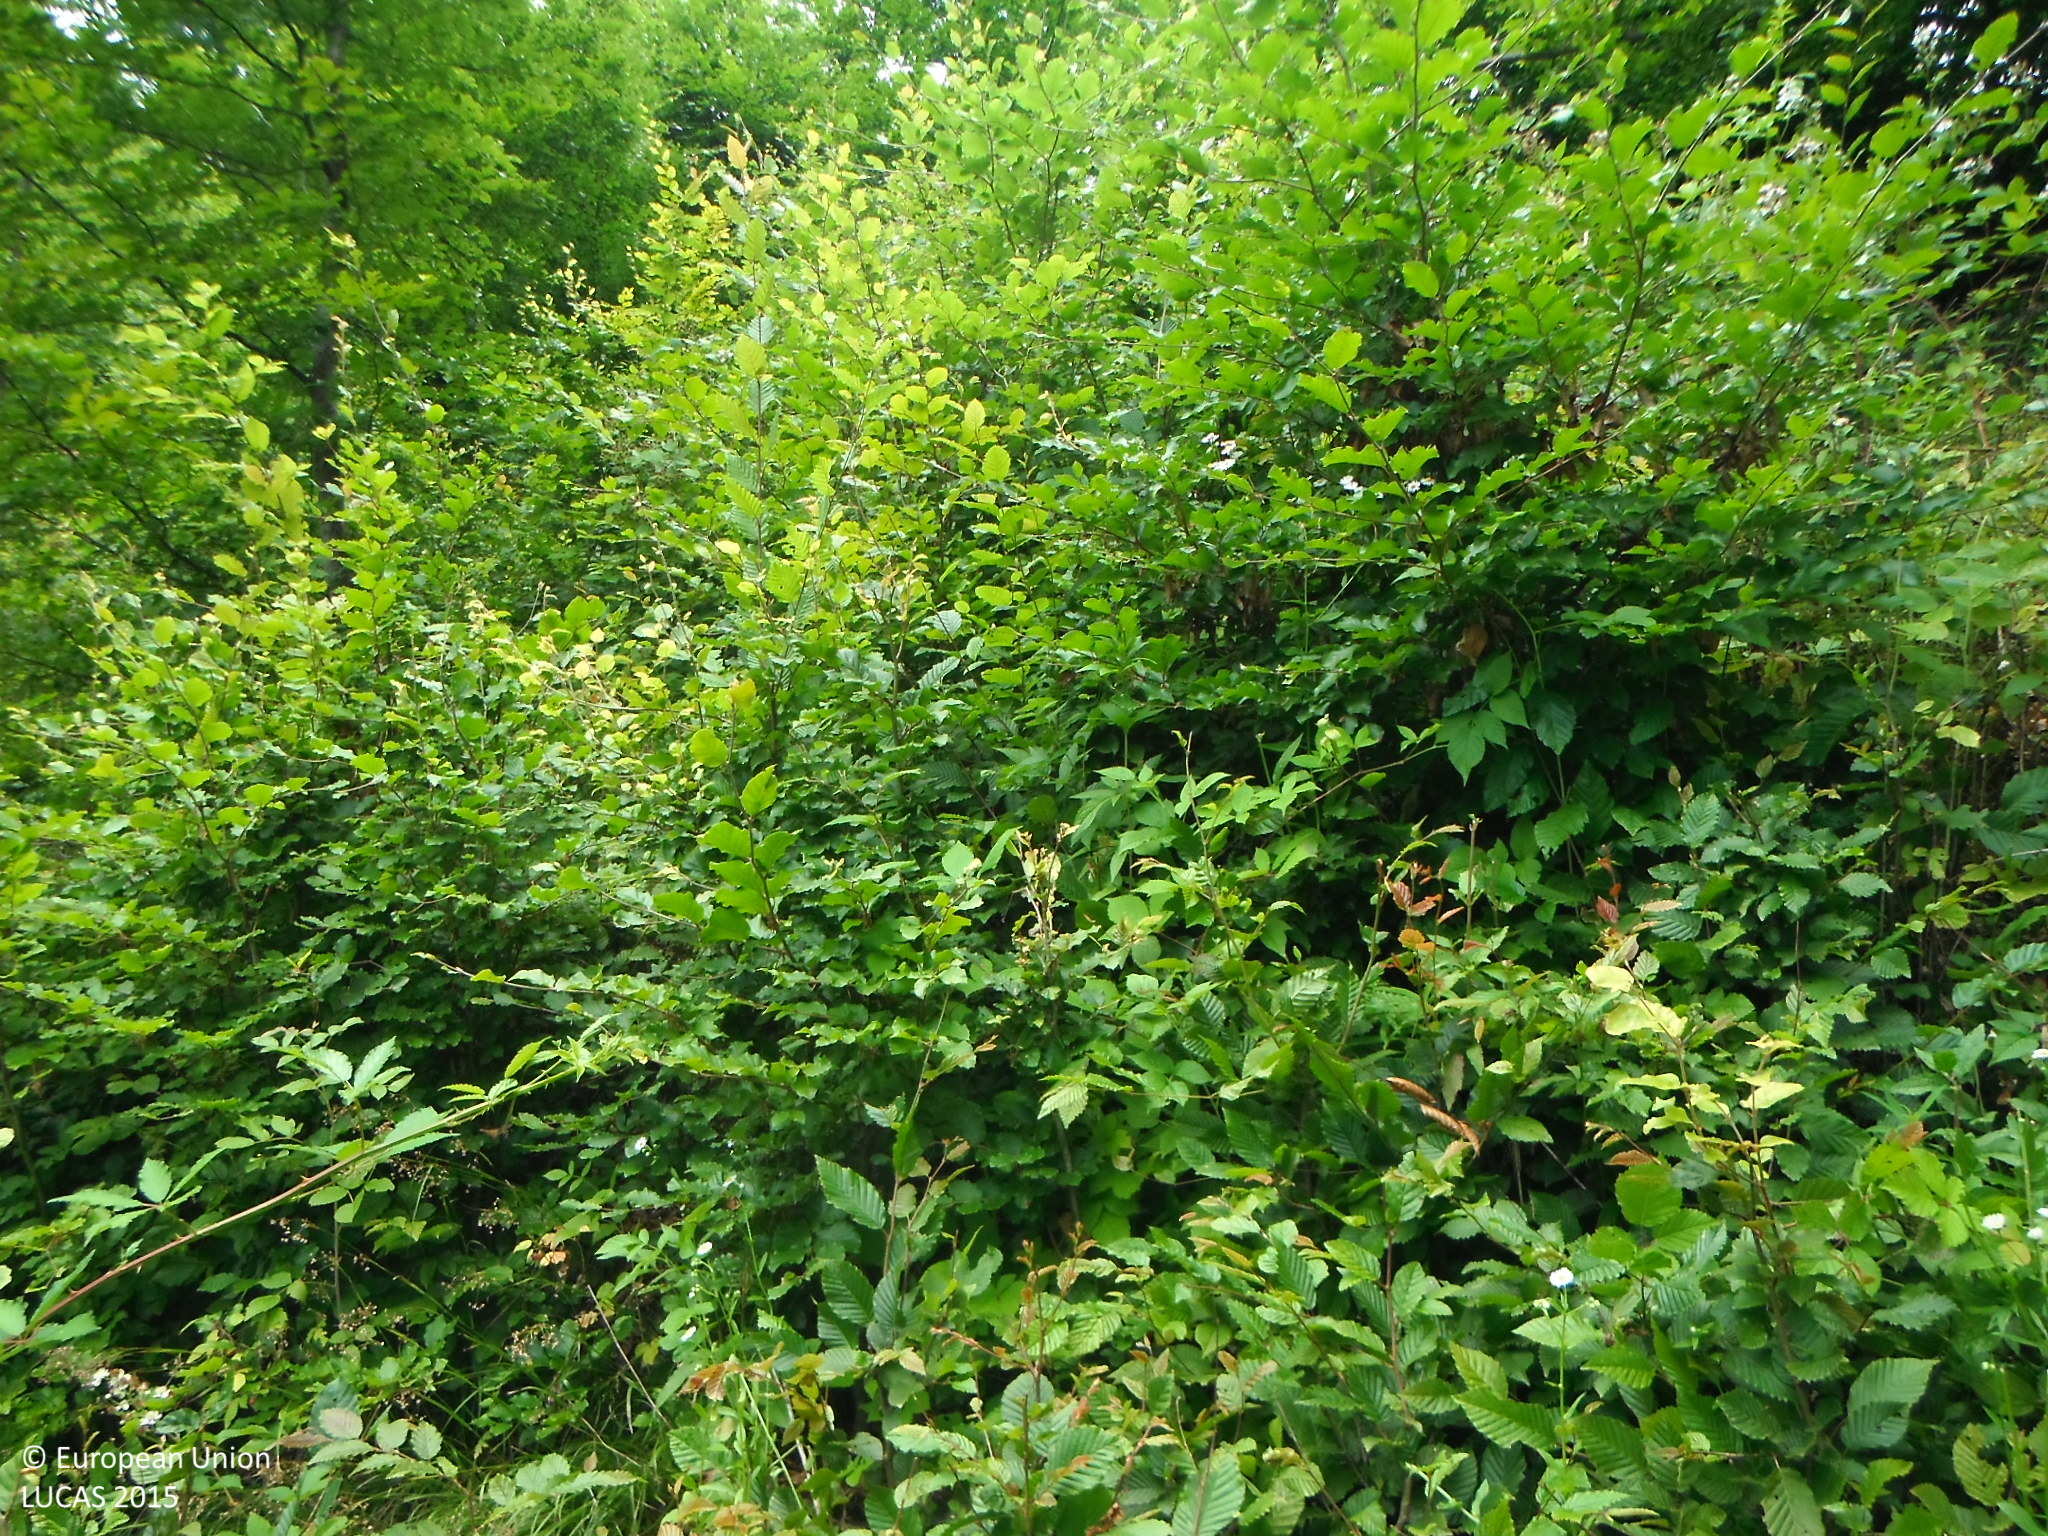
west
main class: Woodland
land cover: Broadleaved woodland
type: beech forest
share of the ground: > 75 %
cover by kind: broadleaved forest trees 90 %, shrubs 10 %
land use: Forestry
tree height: < 5 m
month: July
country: SK
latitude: 48.5872
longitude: 20.1585
